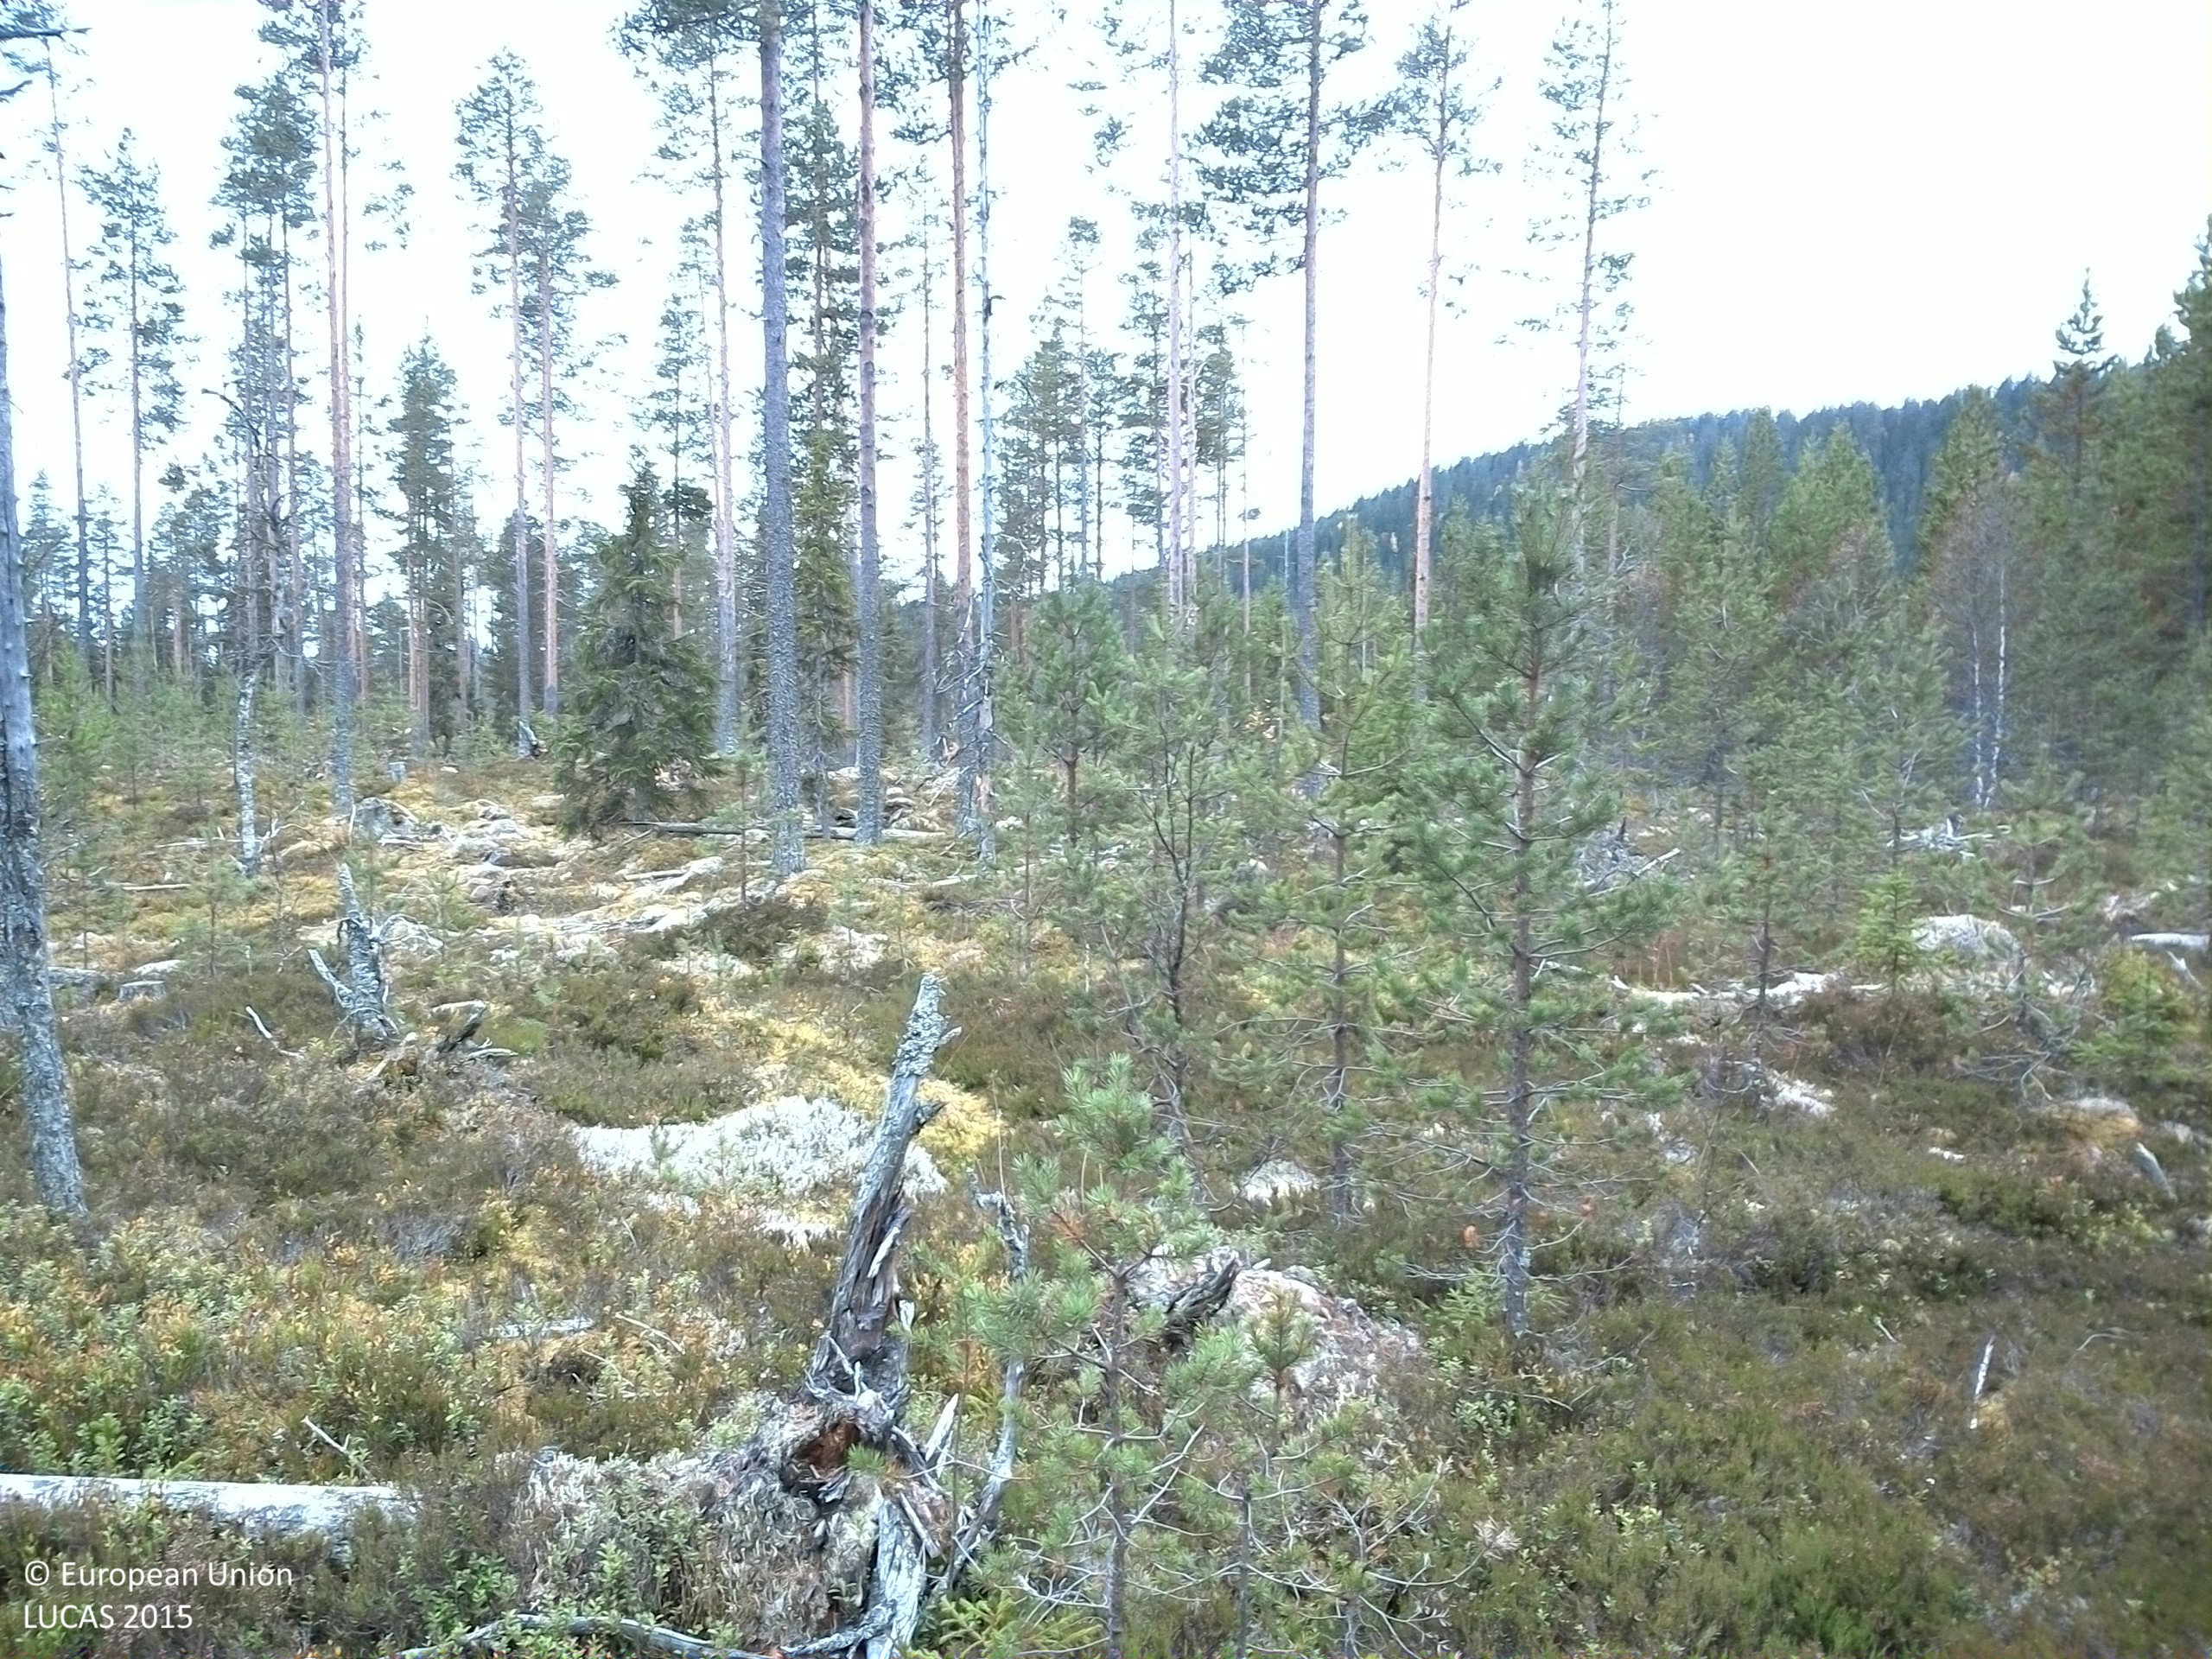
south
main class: Woodland
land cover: Pine dominated coniferous woodland
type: boreal forest
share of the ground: 25 - 50 %
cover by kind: shrubs 45 %, coniferous forest trees 35 %, lichens and mosses 20 %
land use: Forestry
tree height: > 5 m
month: October
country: SE
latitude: 61.5201
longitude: 14.3654
